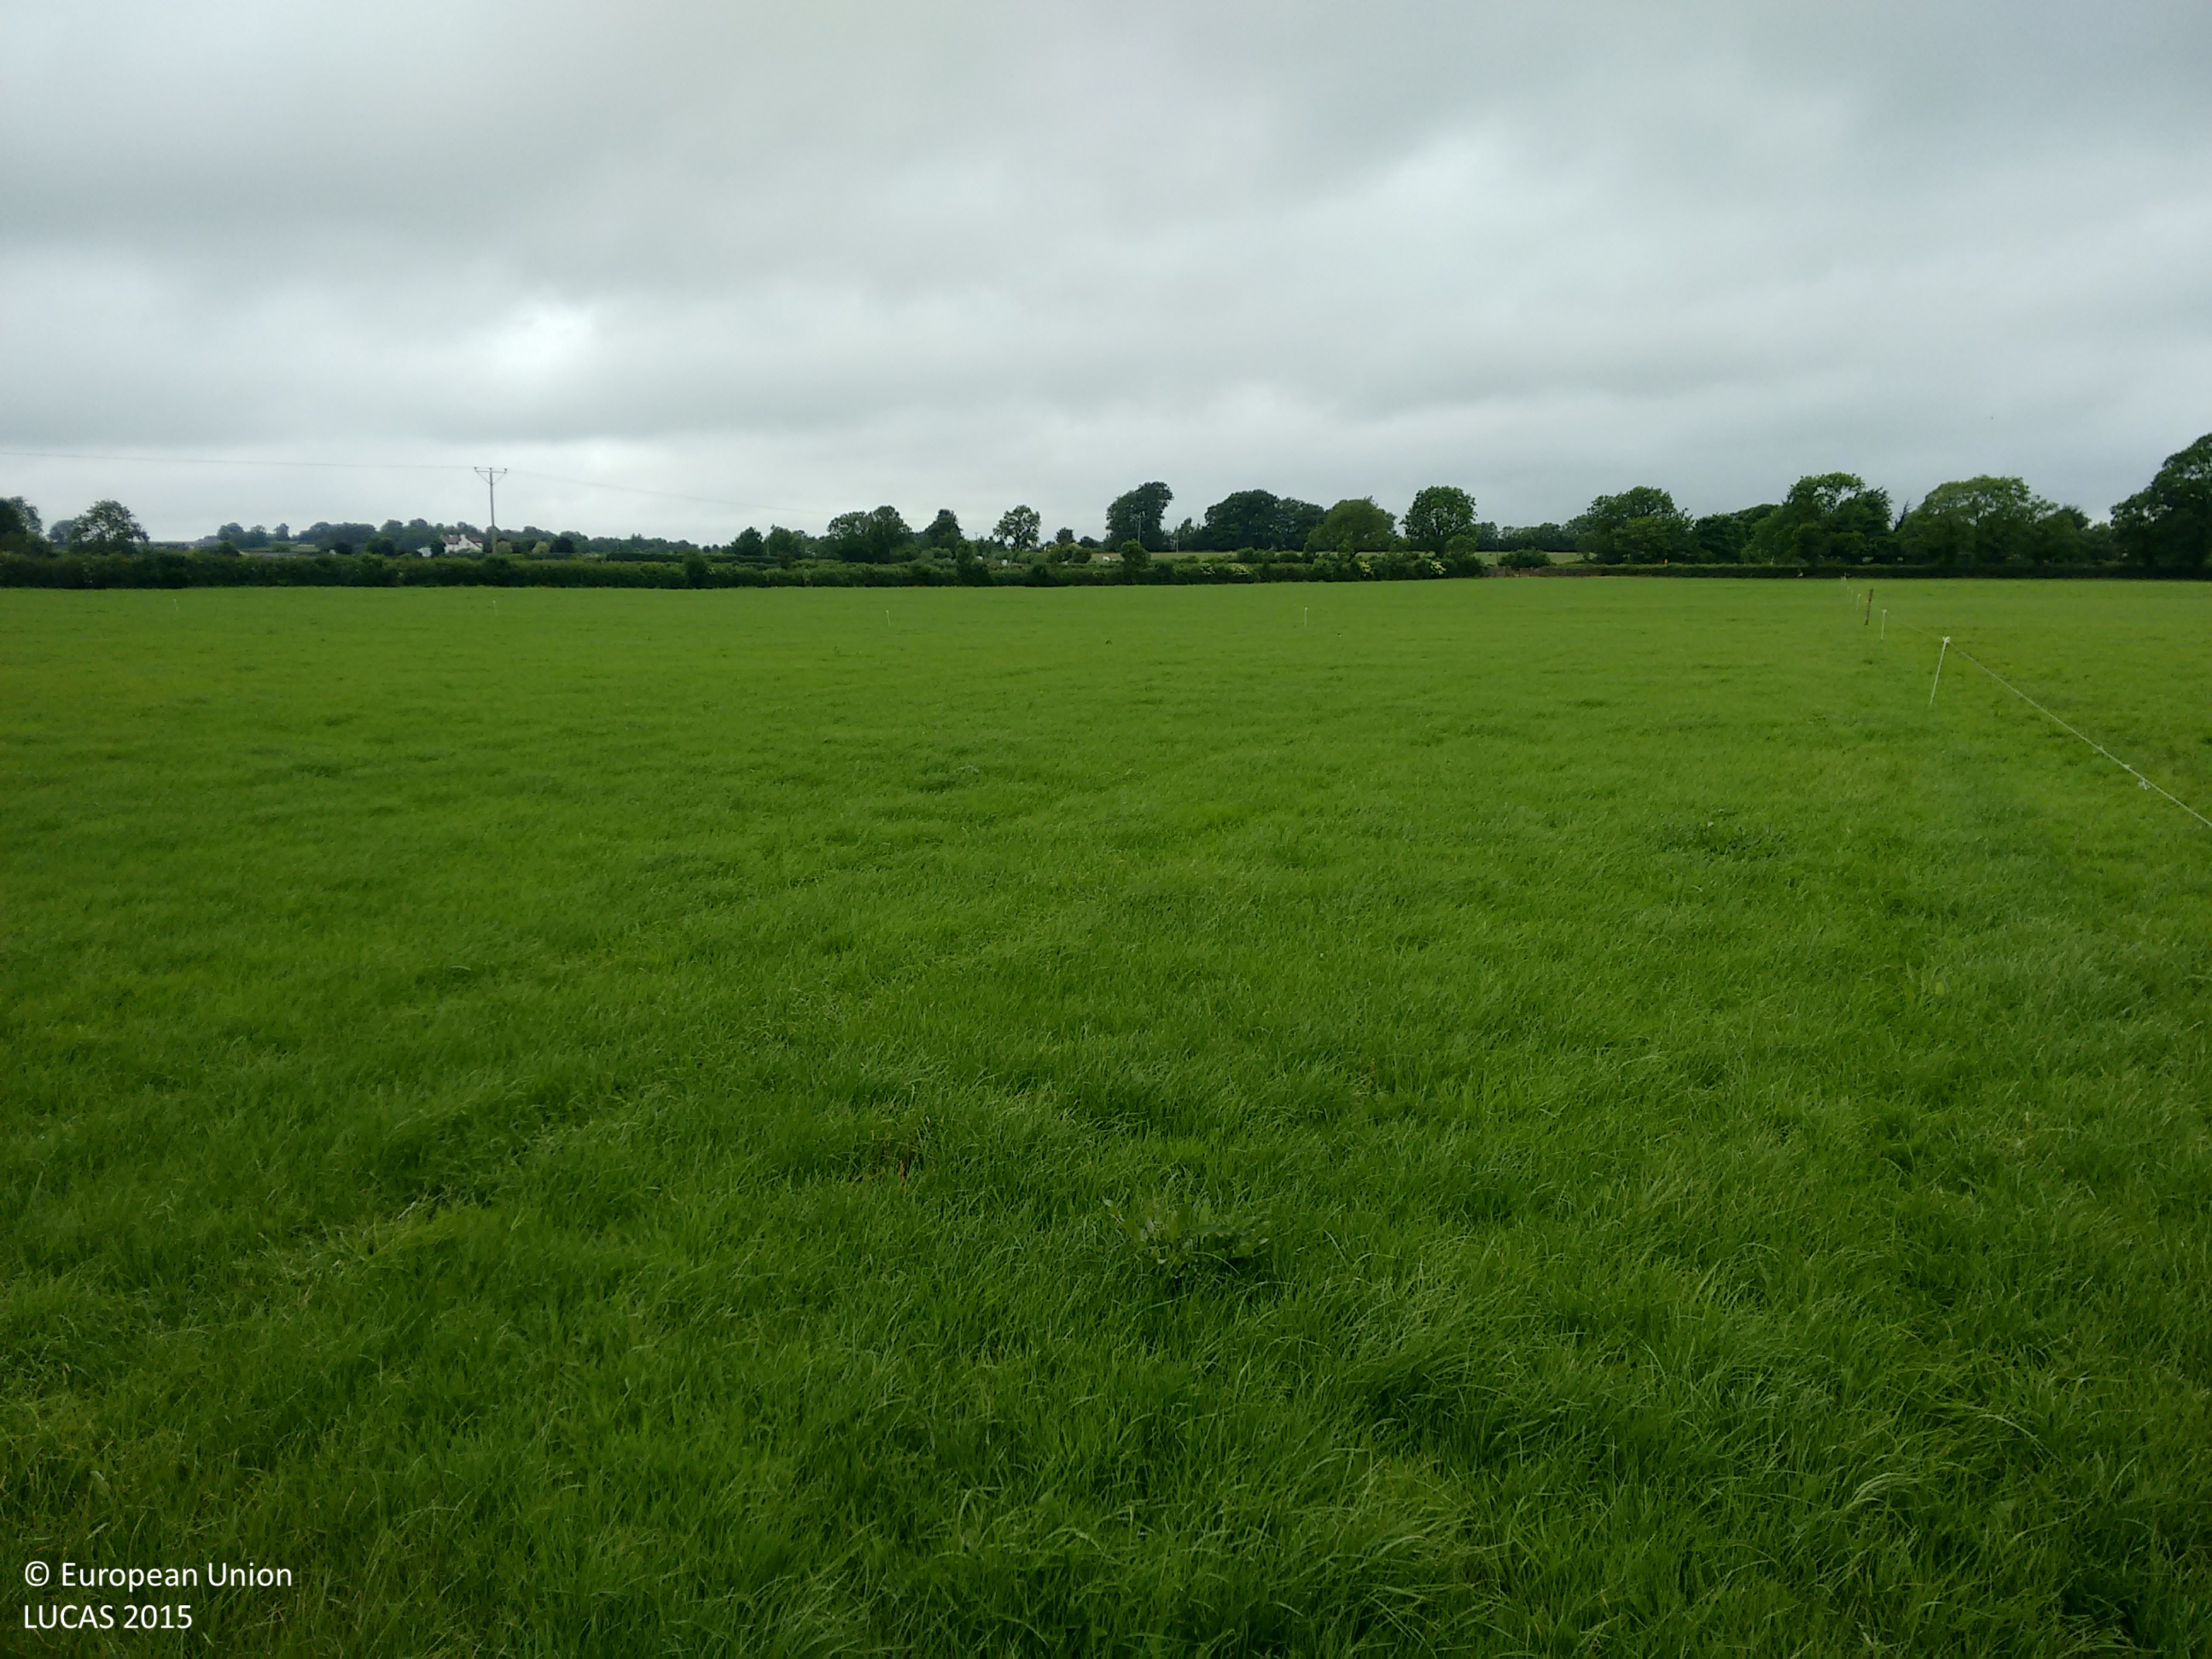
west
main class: Grassland
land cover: Grassland without tree/shrub cover
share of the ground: > 75 %
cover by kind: herbaceous plants 100 %
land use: Agriculture (excluding fallow land and kitchen gardens)
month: June
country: IE
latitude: 52.4819
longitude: -7.2461
